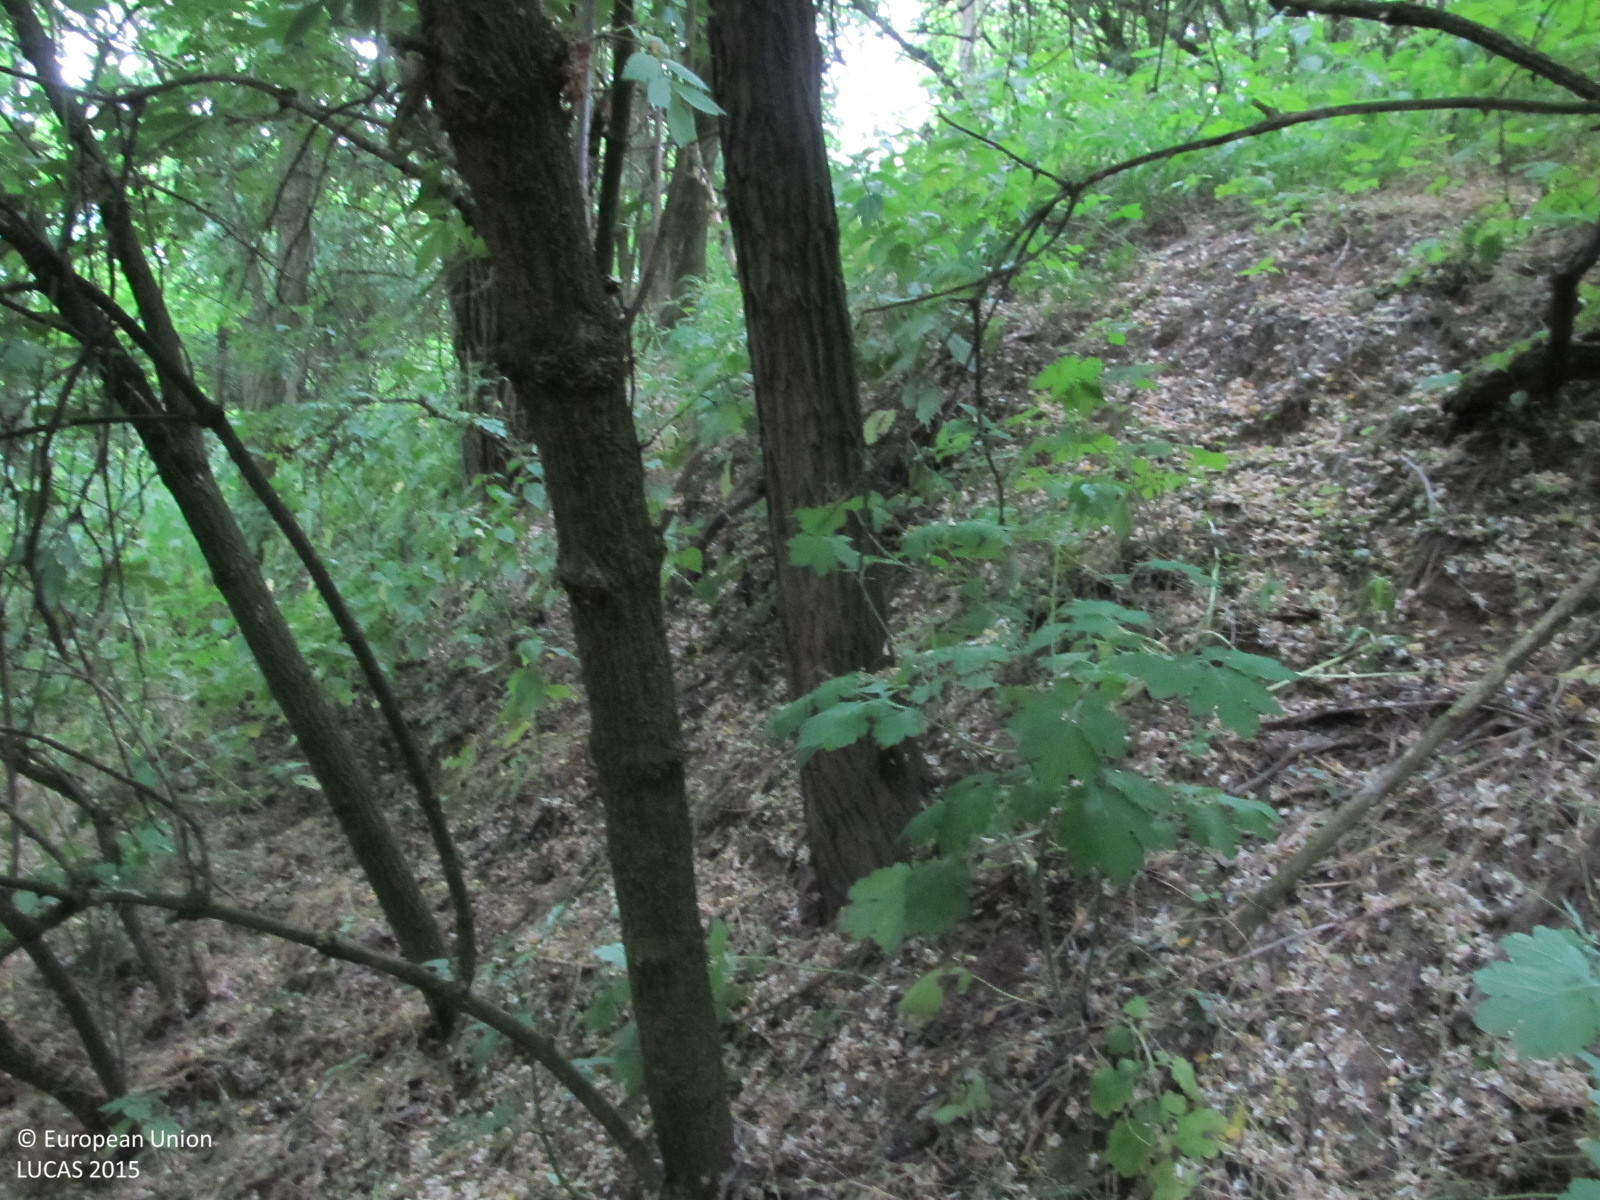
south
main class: Woodland
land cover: Broadleaved woodland
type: exotic forest
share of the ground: > 75 %
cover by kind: broadleaved forest trees 80 %, shrubs 10 %, herbaceous plants 10 %
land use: Semi-natural and natural areas not in use
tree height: > 5 m
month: June
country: AT
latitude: 48.2659
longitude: 15.8637
